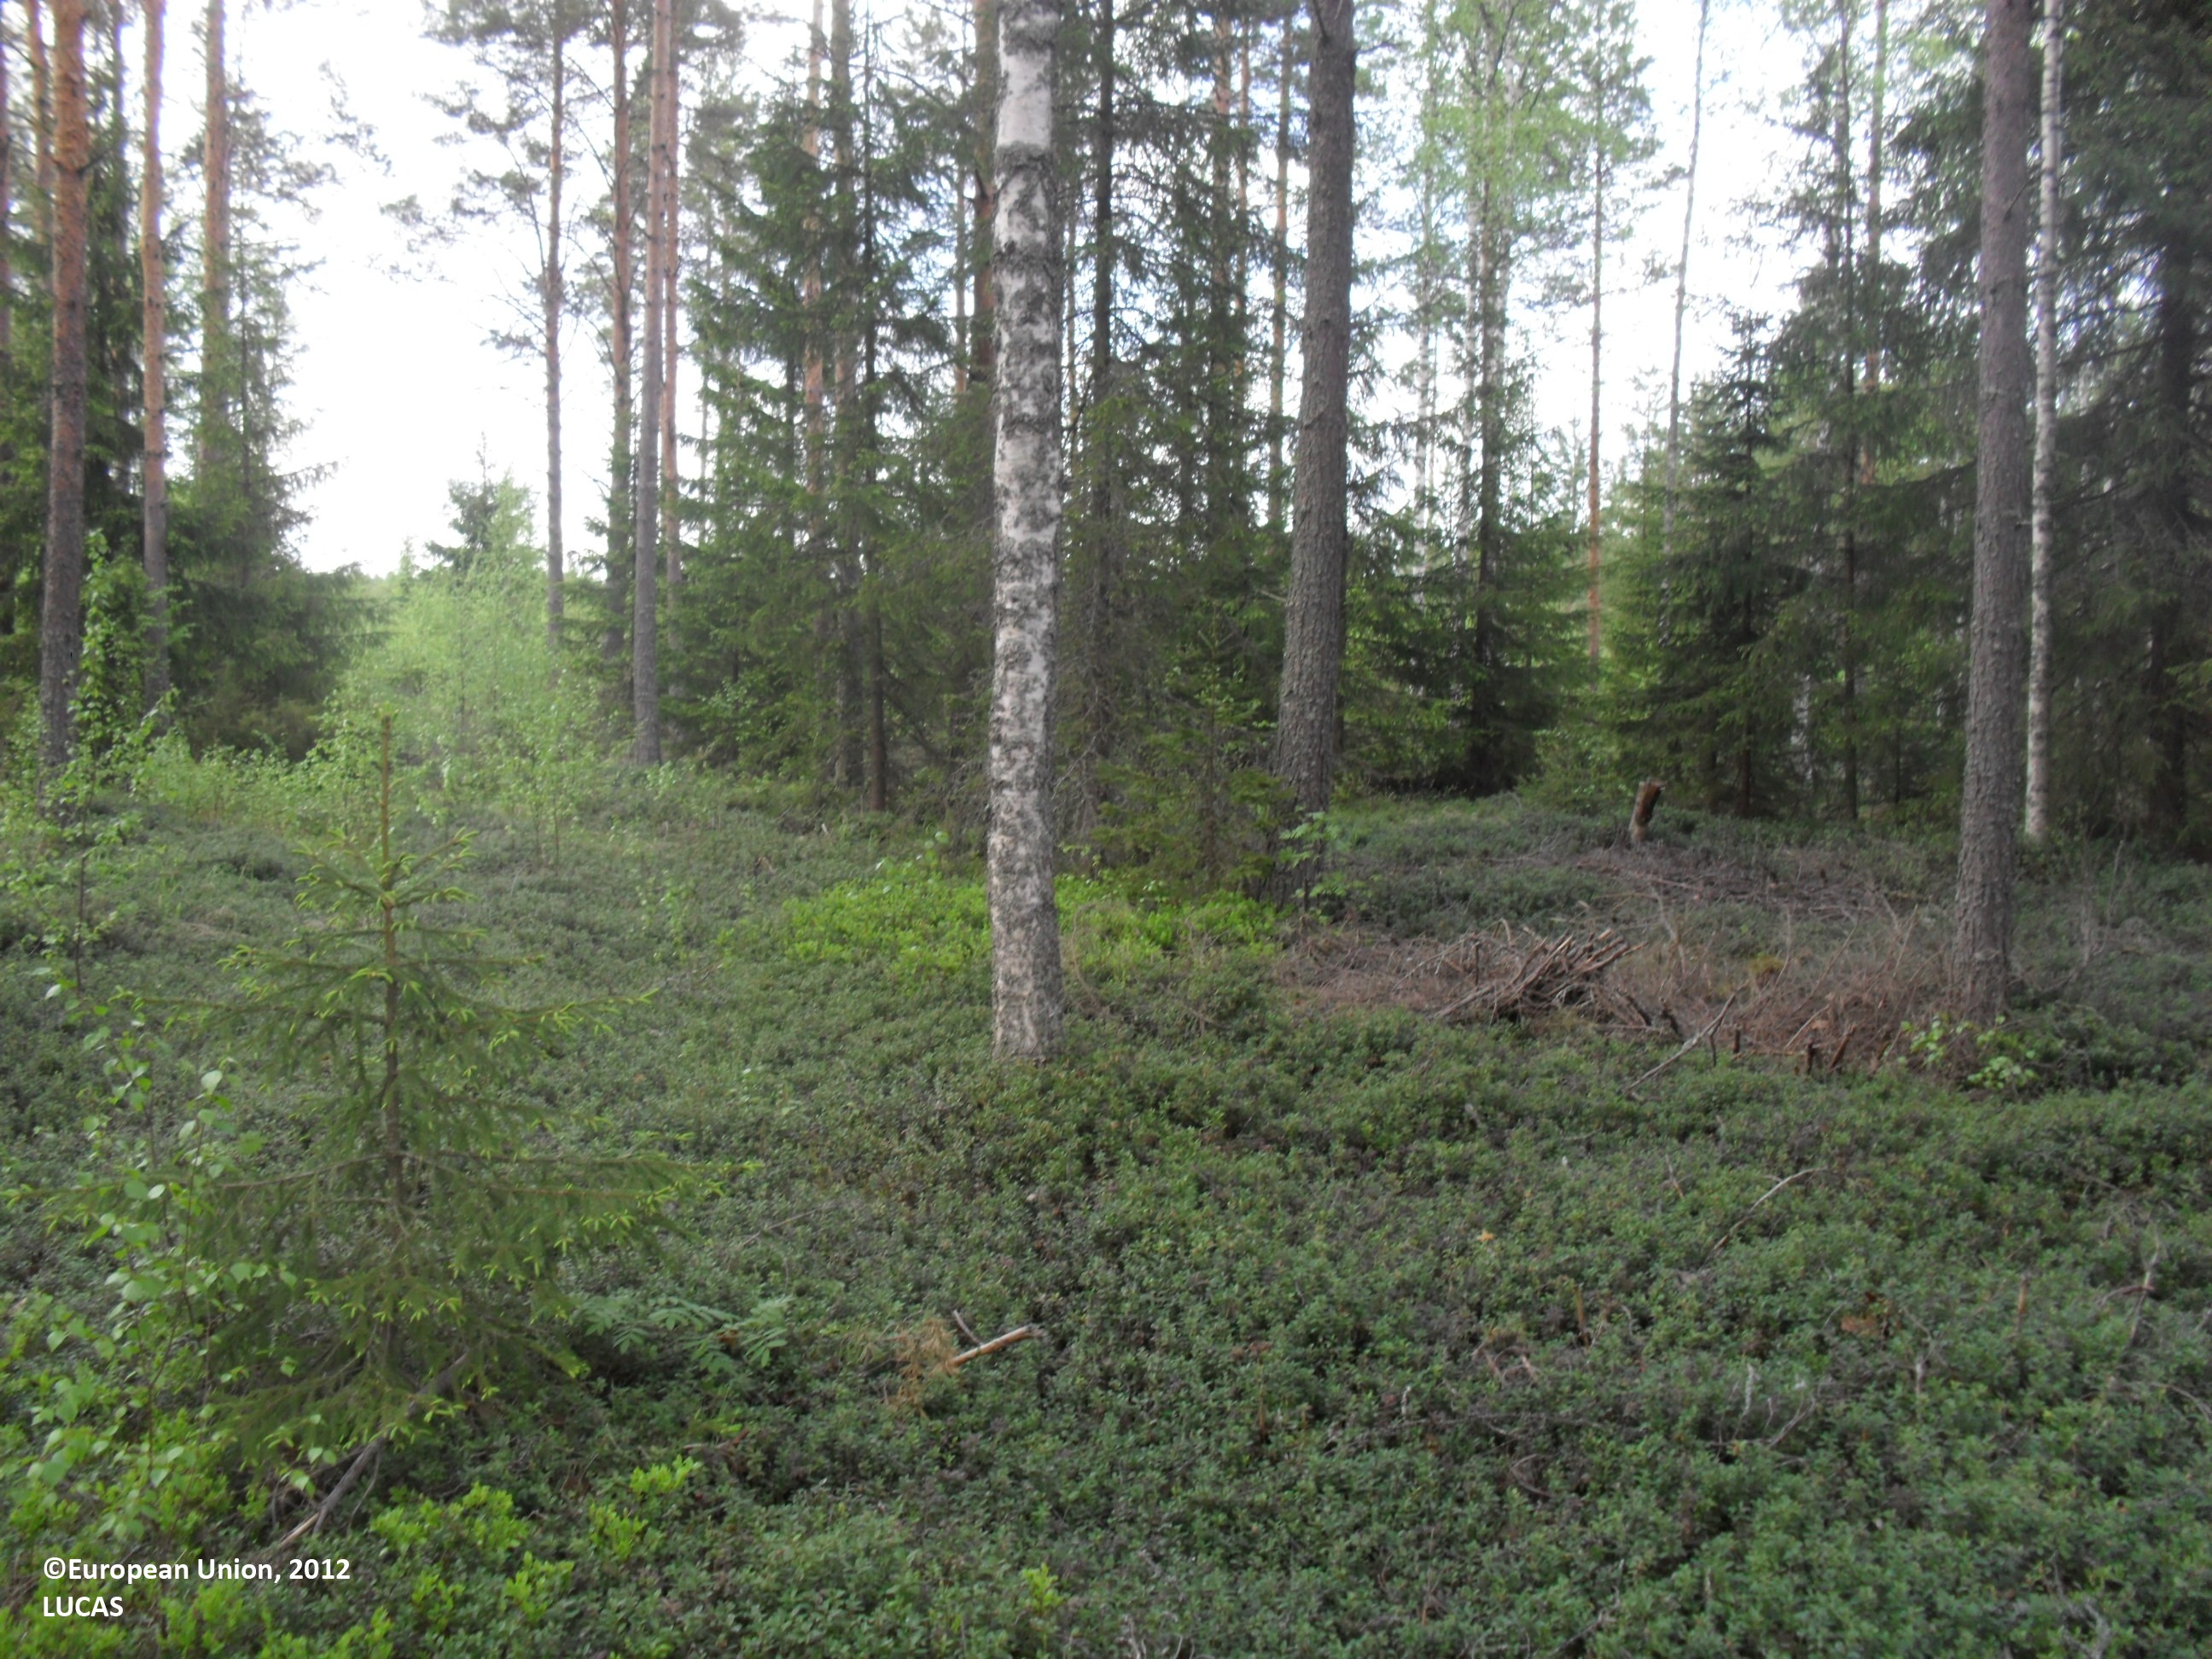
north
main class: Woodland
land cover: Pine dominated mixed woodland
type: boreal forest
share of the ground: 50 - 75 %
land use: Forestry
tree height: > 5 m
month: June
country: FI
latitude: 62.8281
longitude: 23.2744
